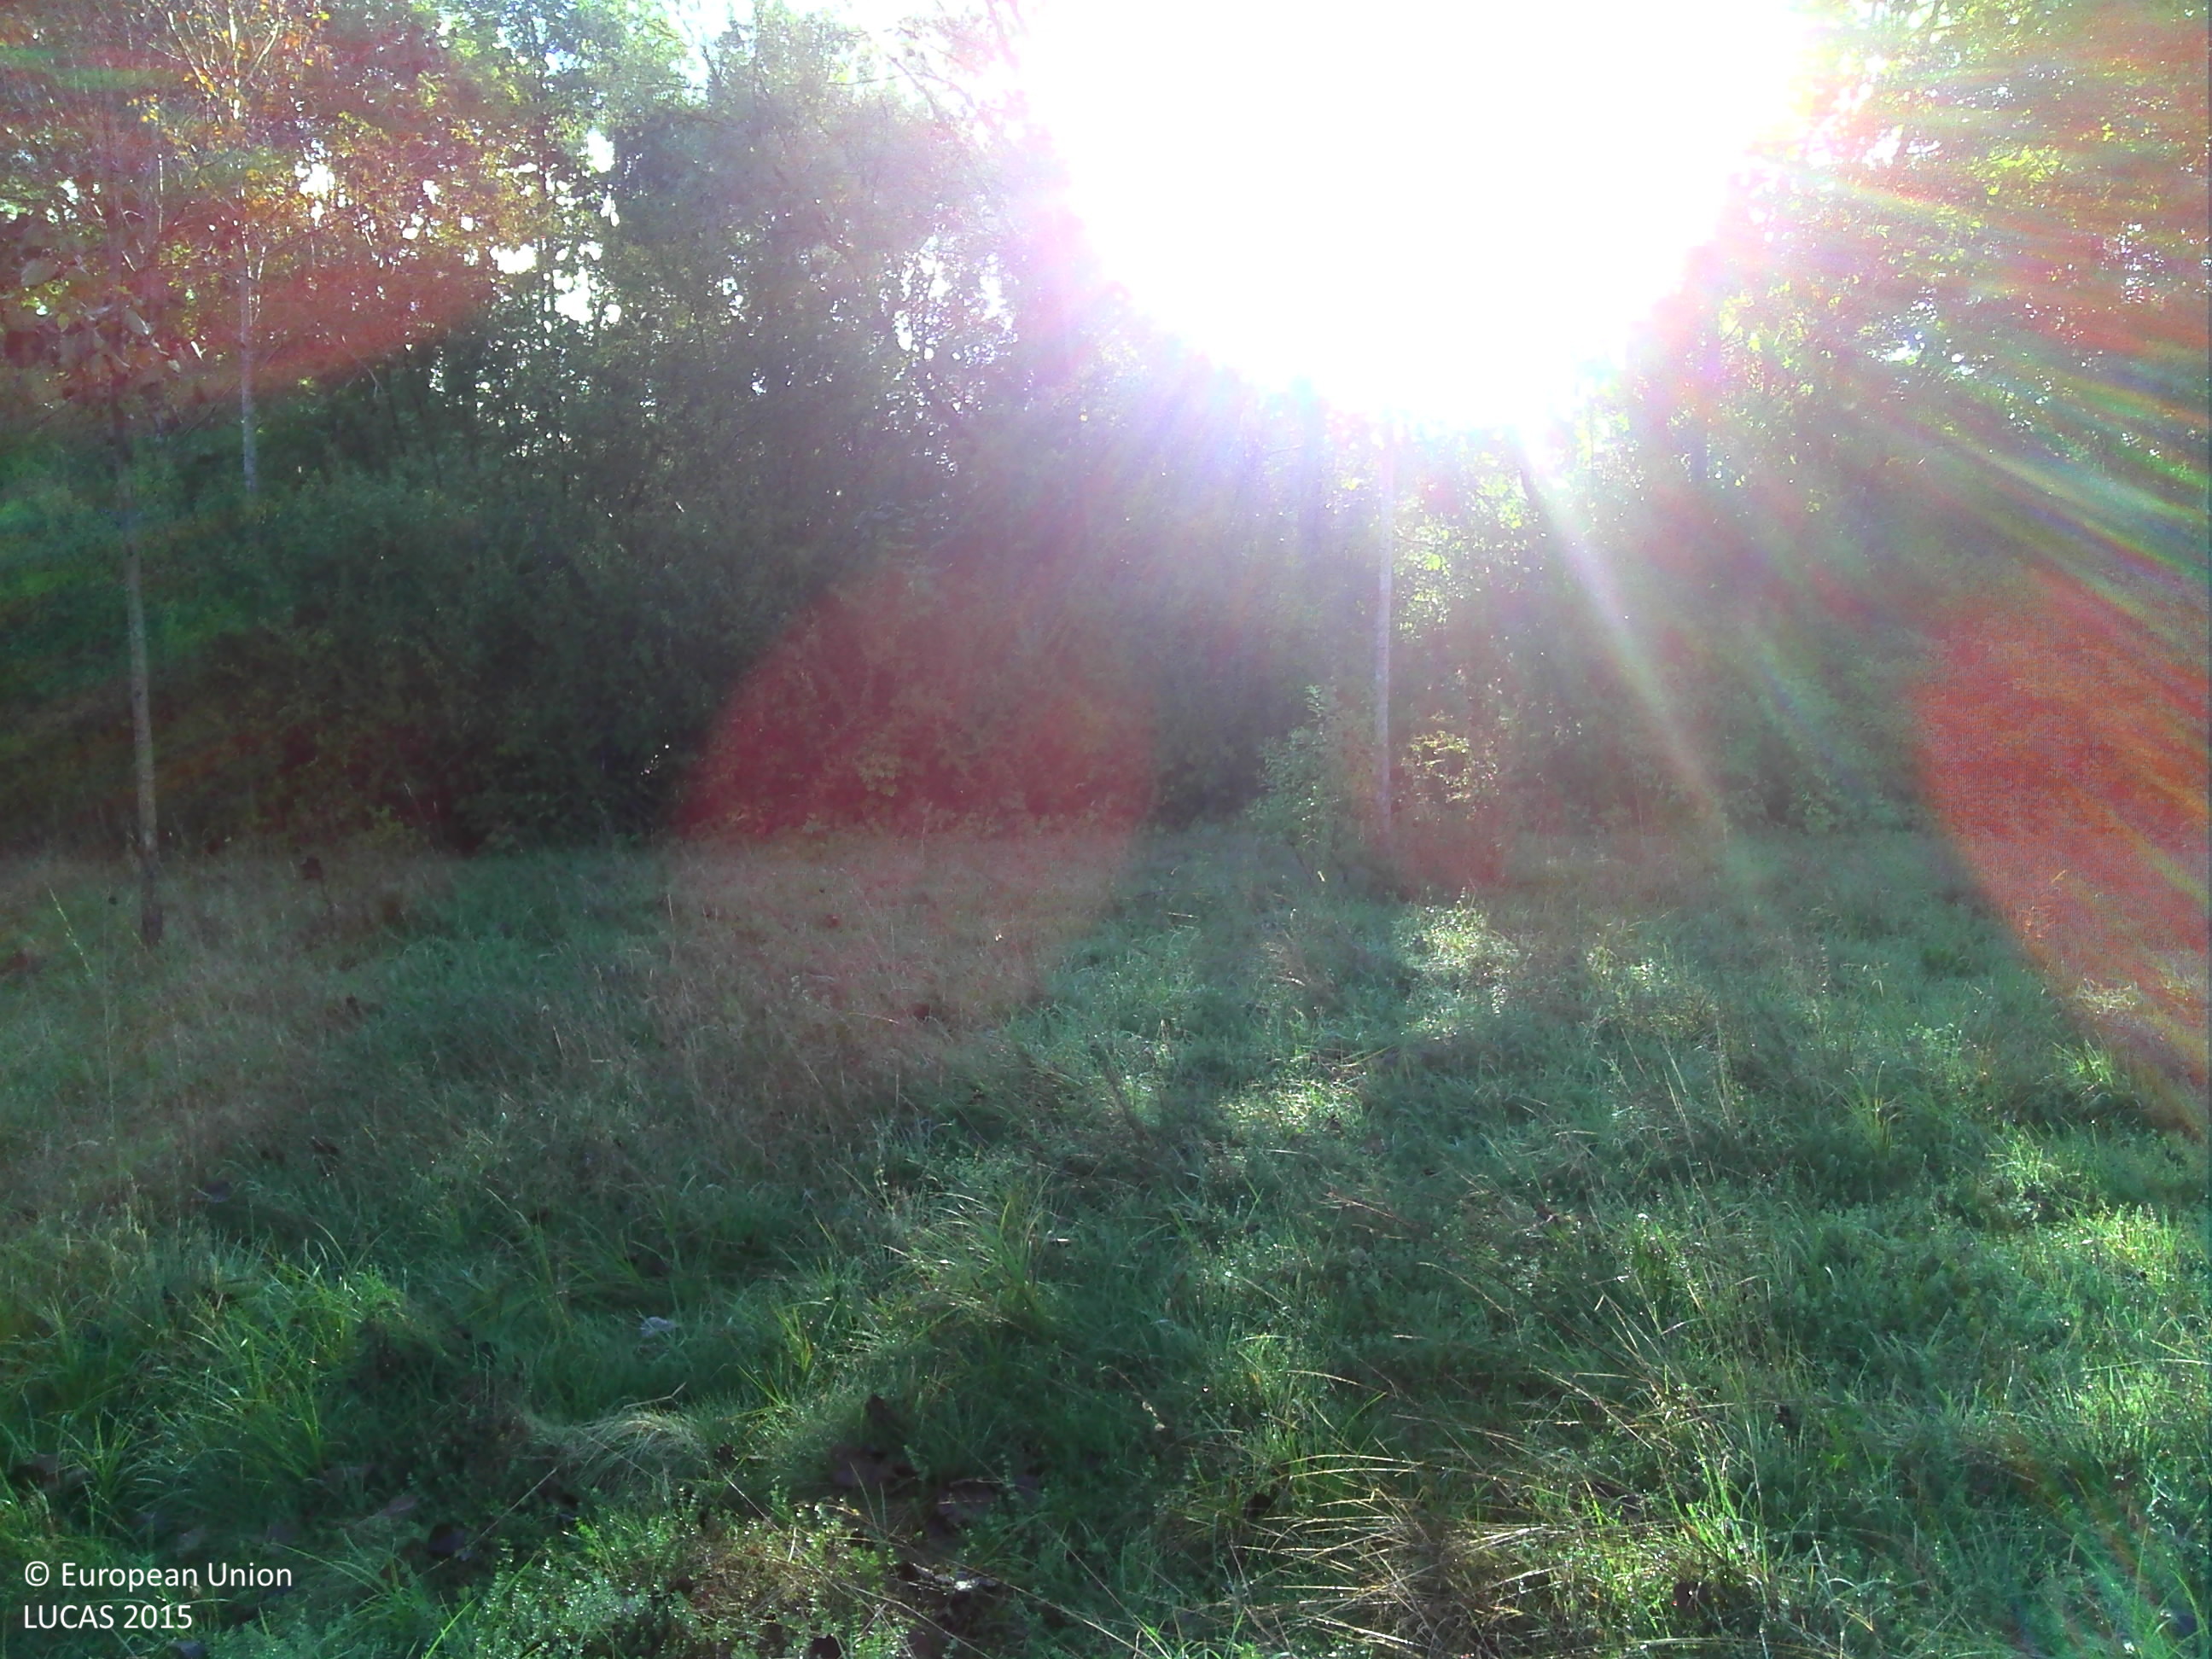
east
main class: Woodland
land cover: Broadleaved woodland
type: exotic forest
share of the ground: 25 - 50 %
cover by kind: herbaceous plants 65 %, broadleaved forest trees 35 %
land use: Forestry
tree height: > 5 m
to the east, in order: Broadleaved woodland; Inland fresh running water; Broadleaved woodland; Inland fresh running water; Broadleaved woodland; Grass margins; Maize; Broadleaved woodland; Inland fresh running water
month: September
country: FR
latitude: 48.1548
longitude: 4.7961
